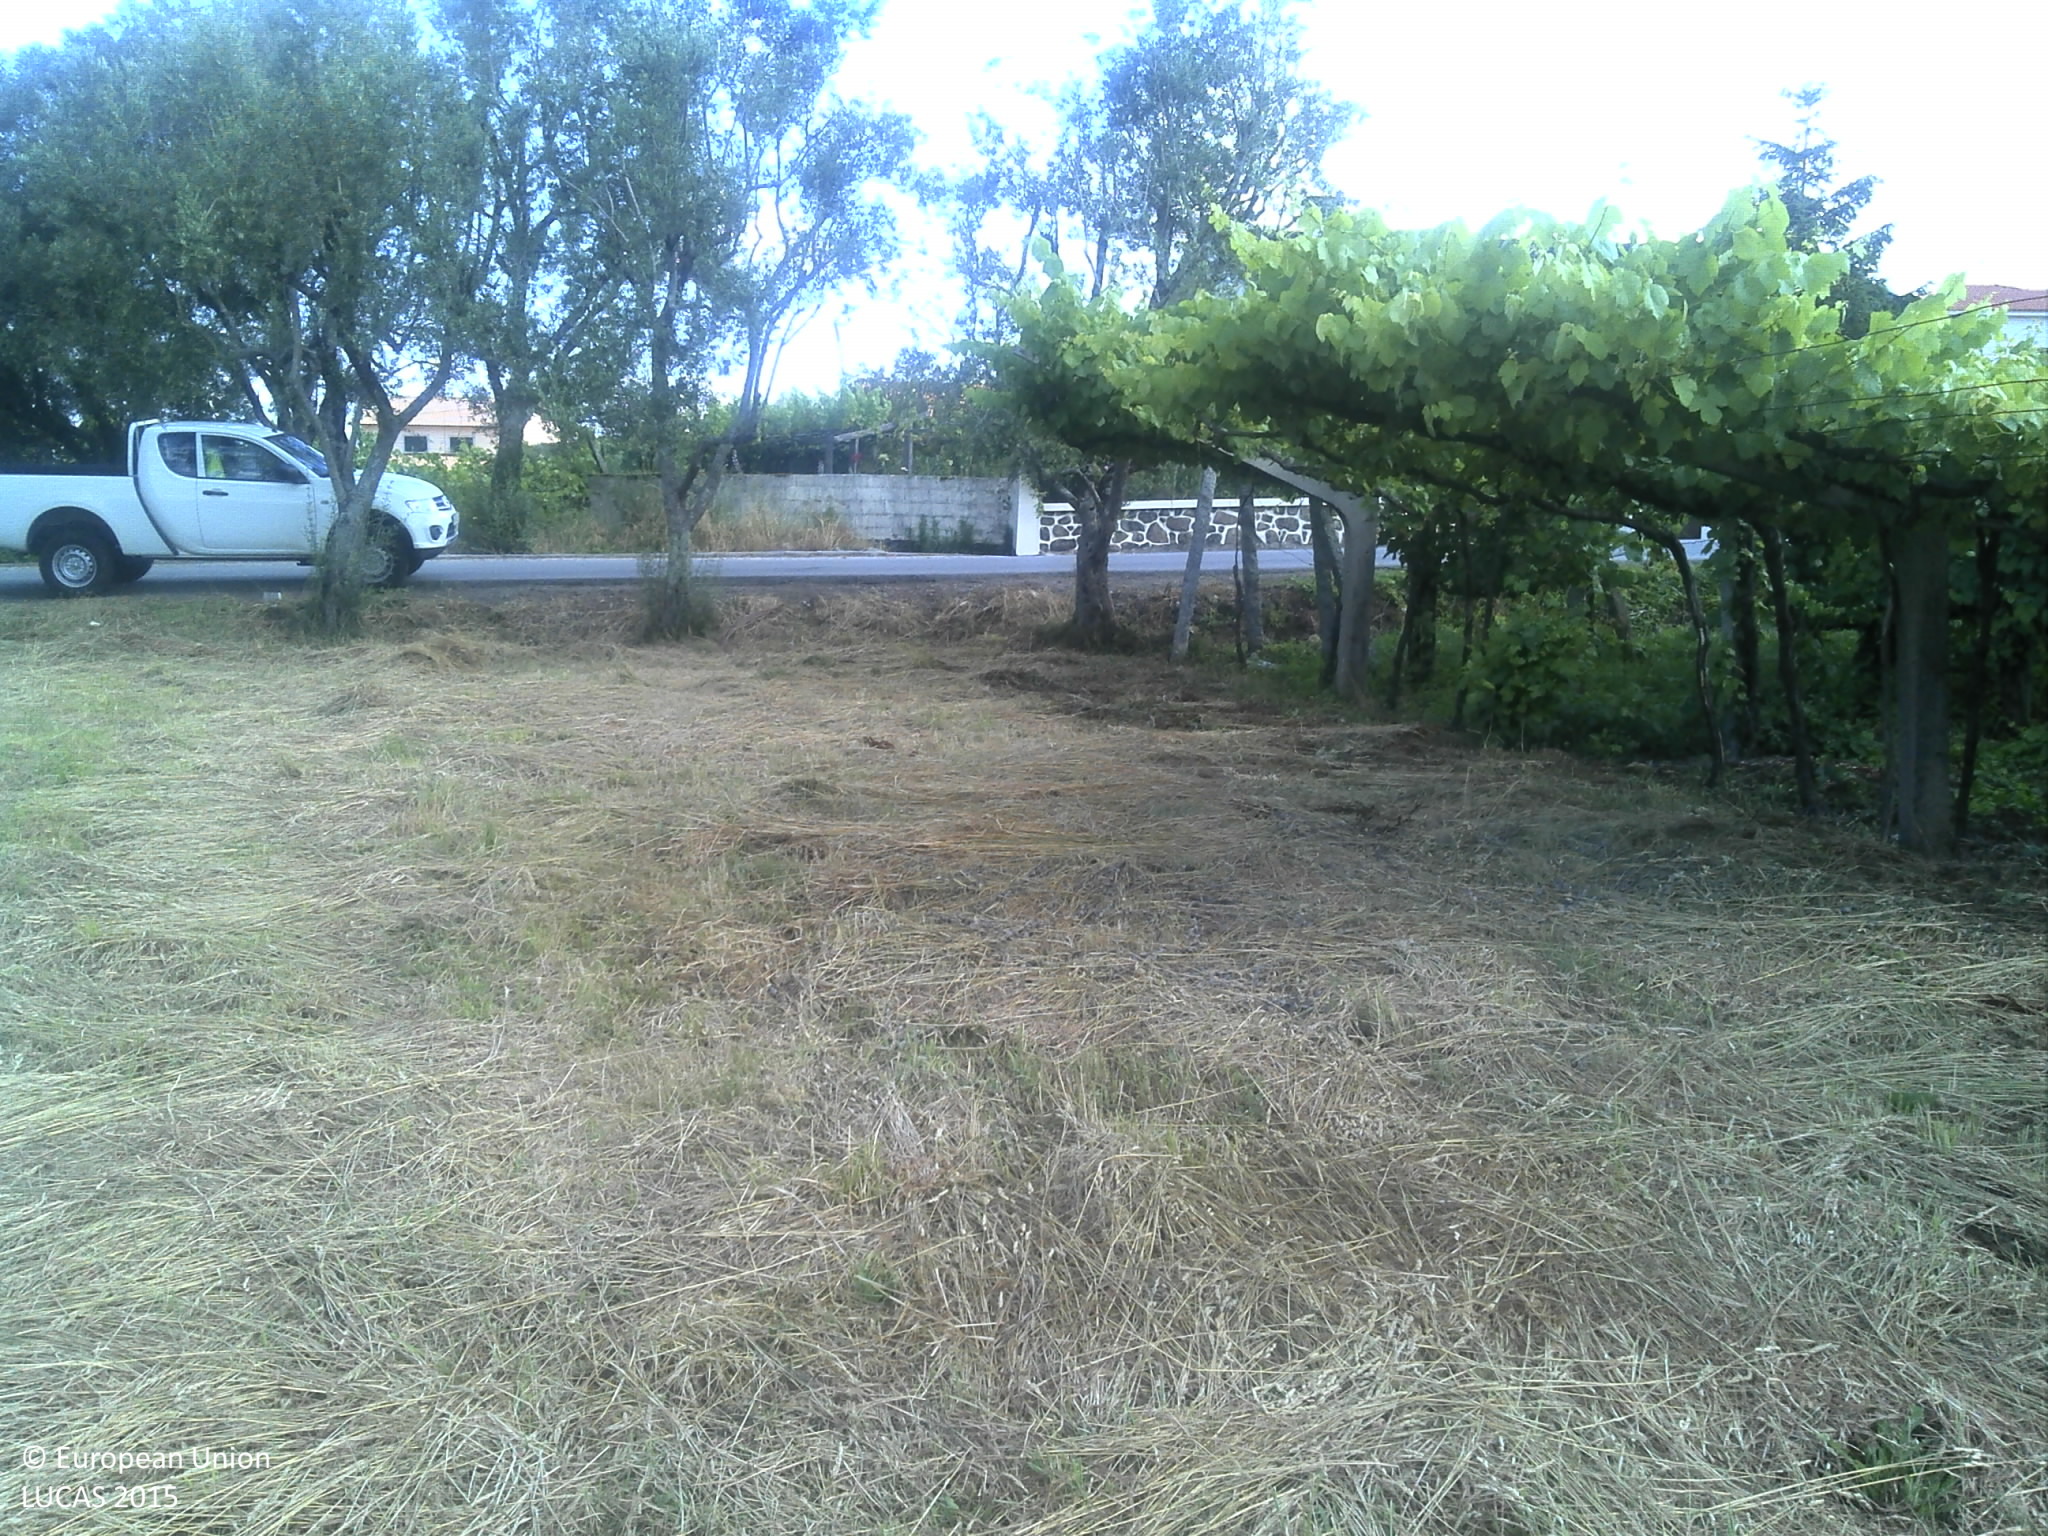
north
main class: Cropland
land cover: Temporary grasslands
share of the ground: 50 - 75 %
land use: Agriculture (excluding fallow land and kitchen gardens)
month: June
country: PT
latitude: 41.6142
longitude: -8.7042
